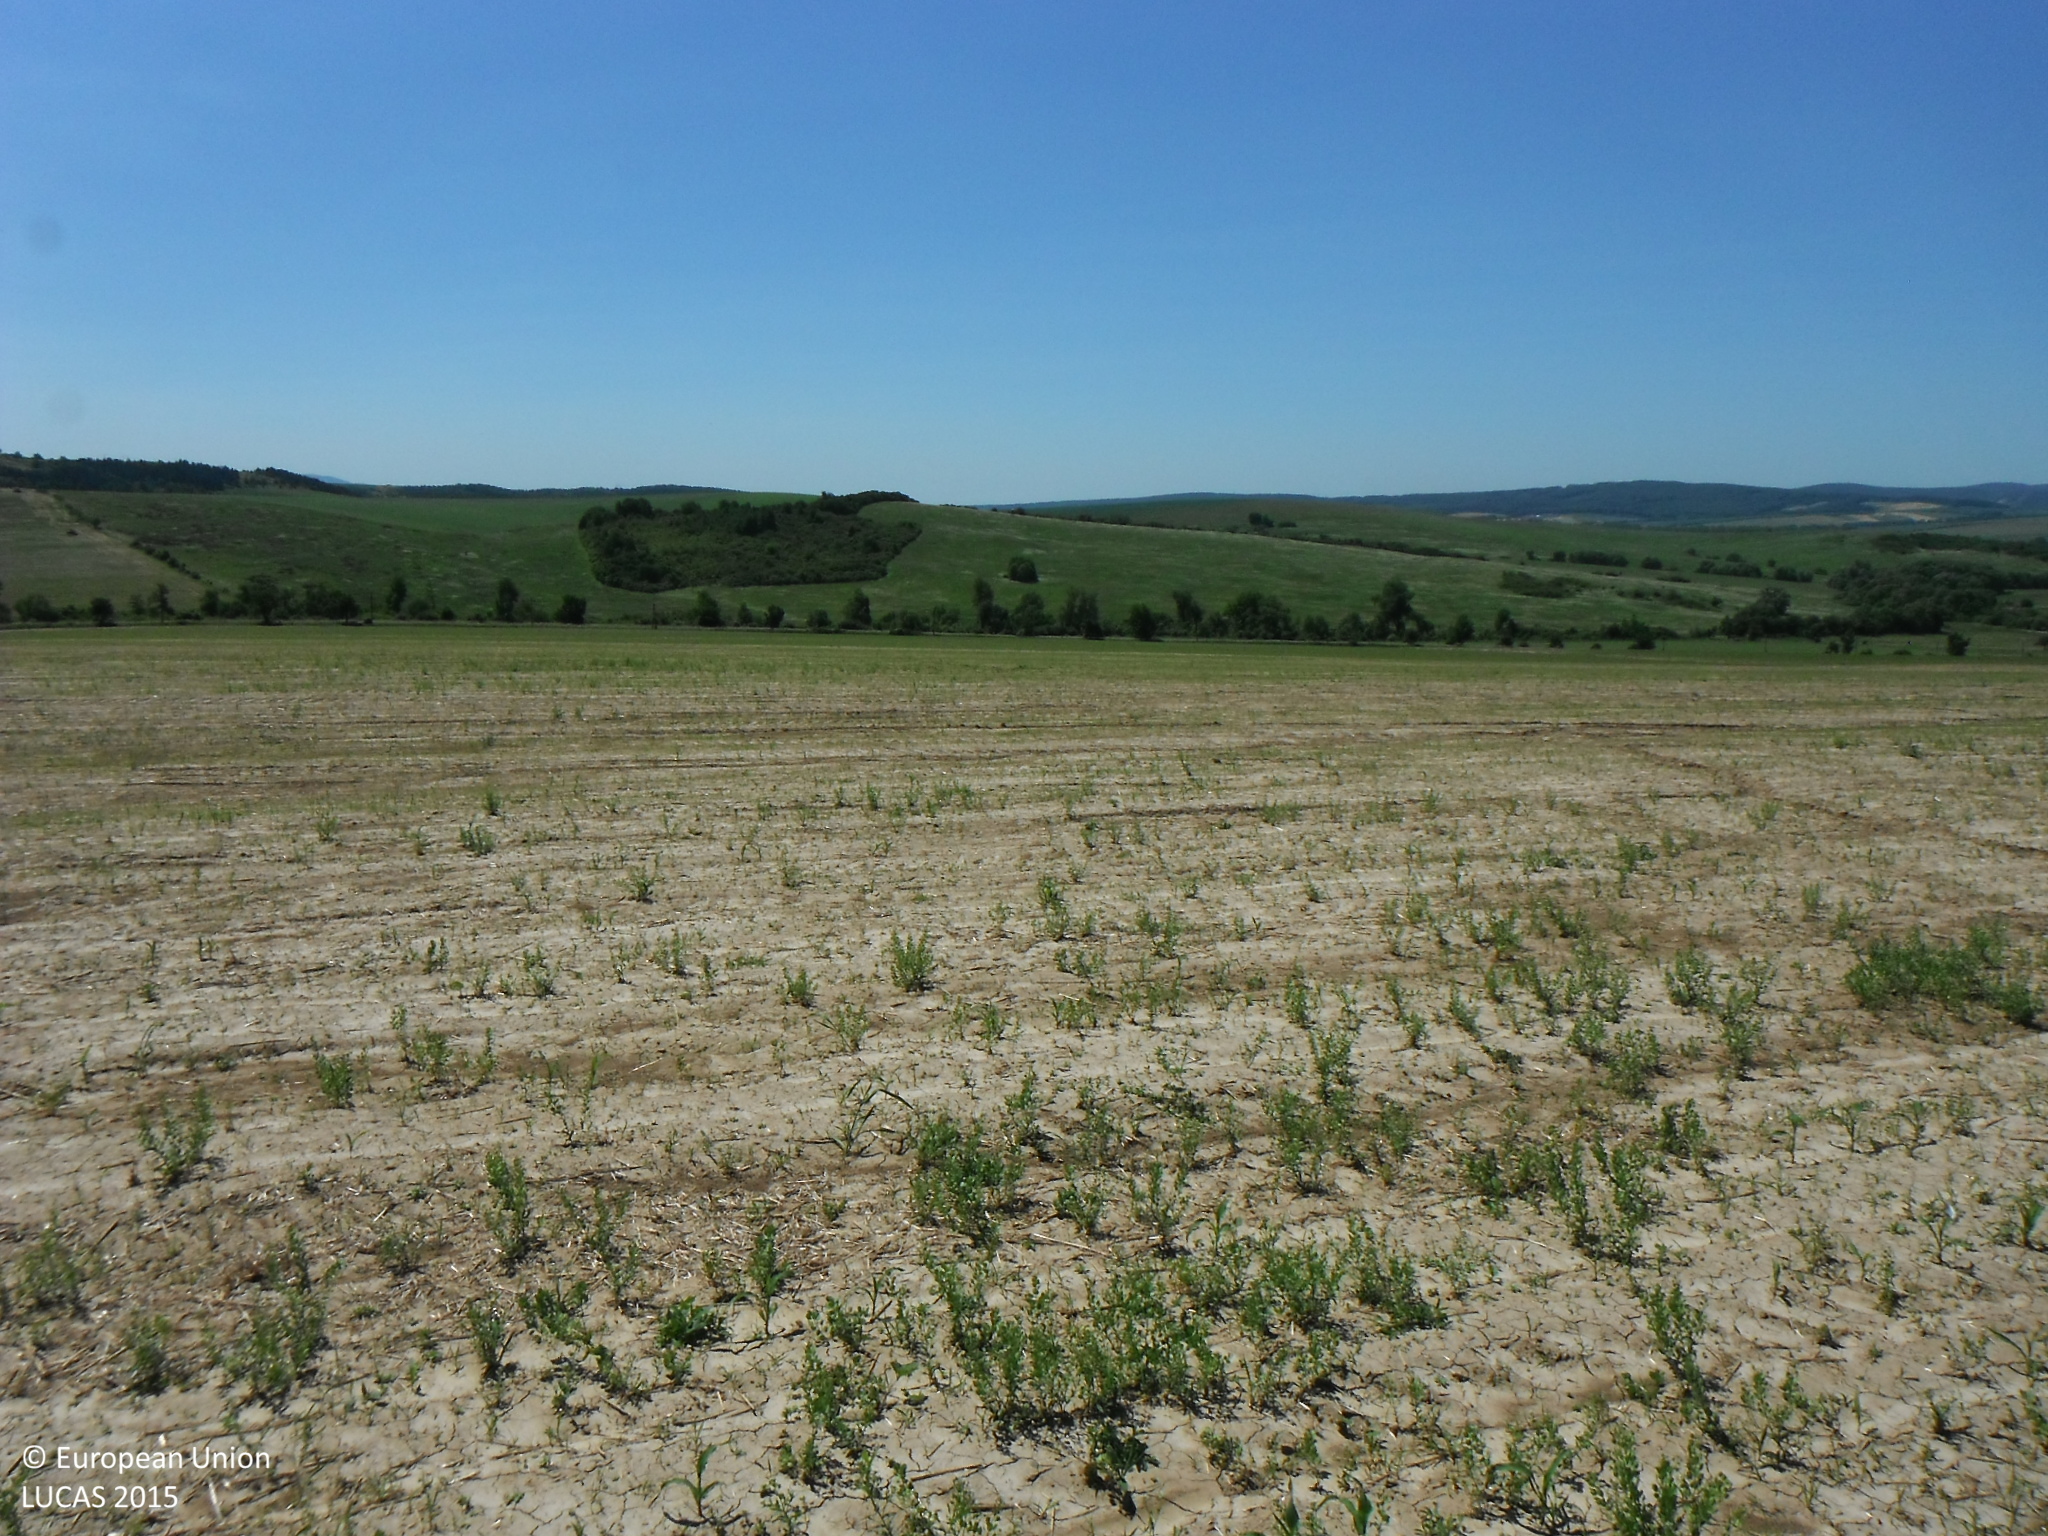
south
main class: Cropland
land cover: Maize
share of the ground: < 10 %
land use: Agriculture (excluding fallow land and kitchen gardens)
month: June
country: SK
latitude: 48.8531
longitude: 21.3442
